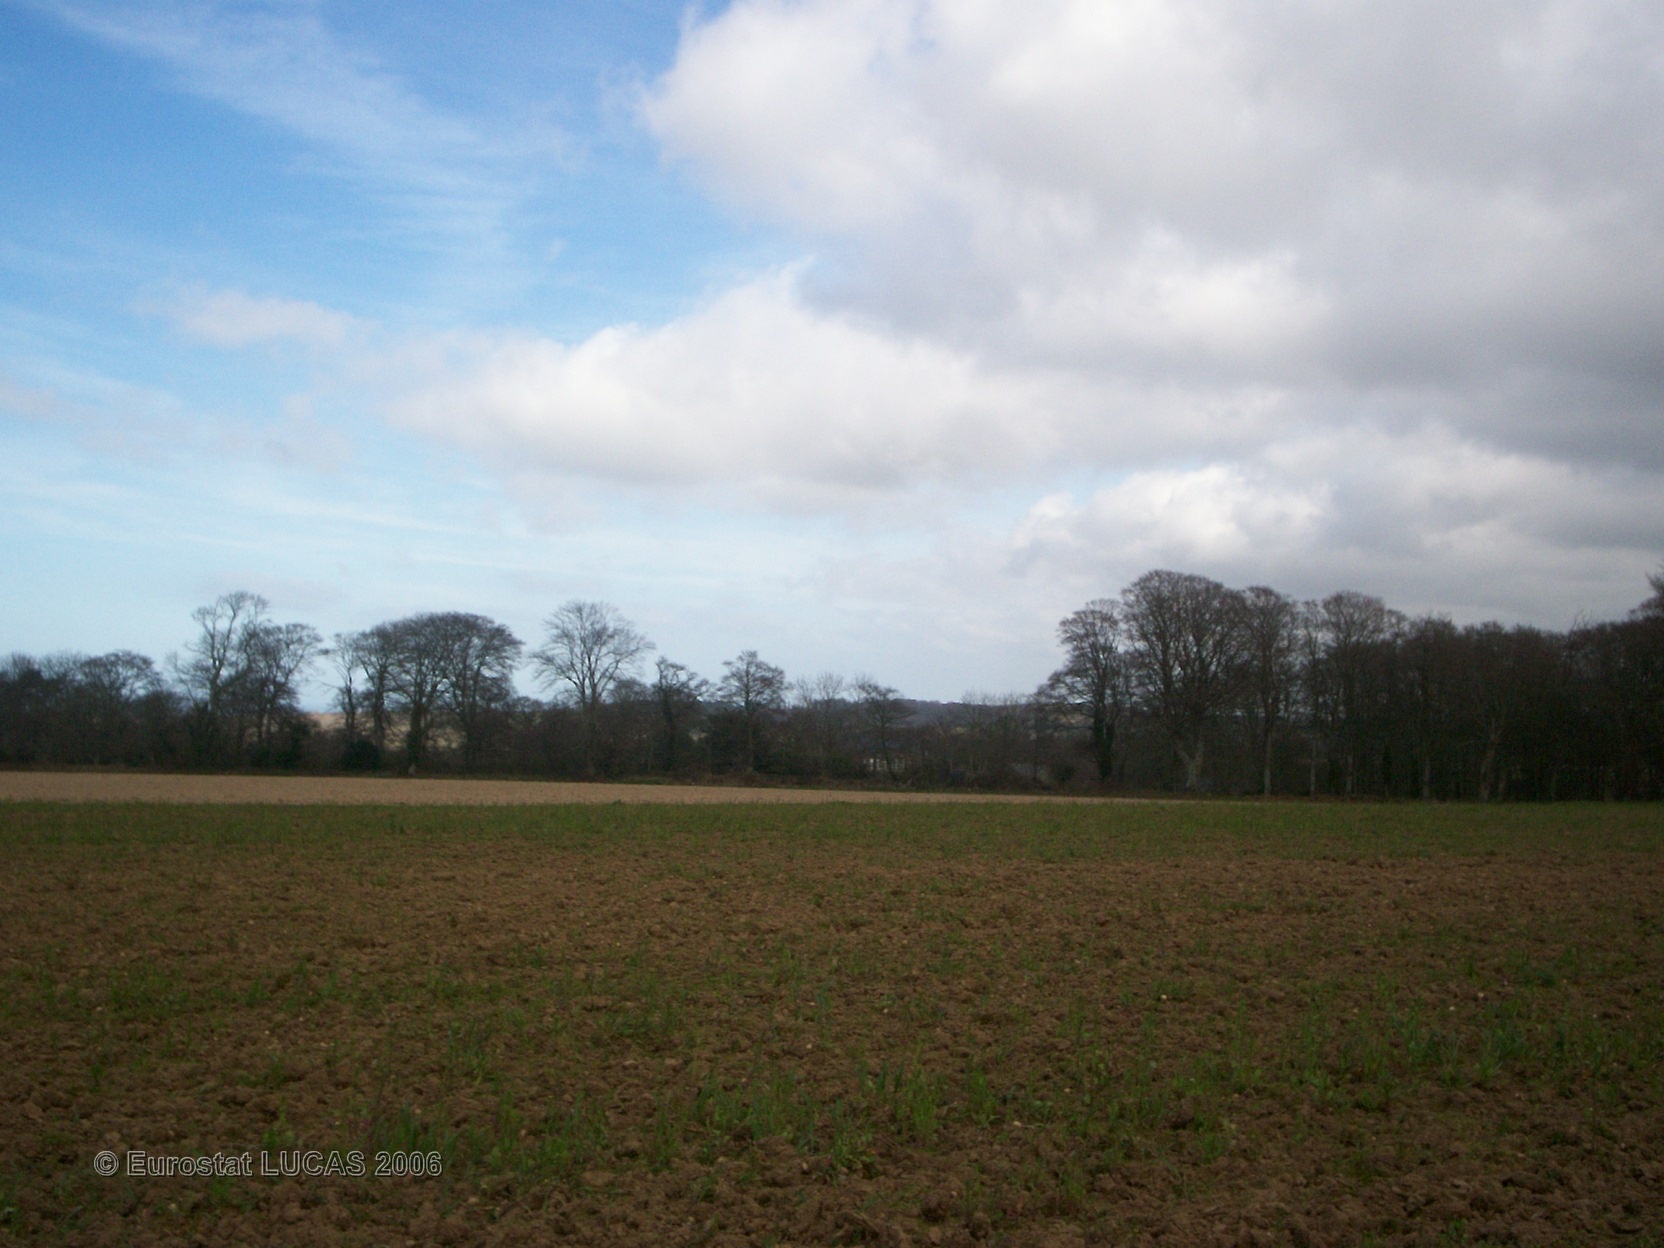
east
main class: Cropland
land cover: Maize
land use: Agriculture (excluding fallow land and kitchen gardens)
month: May
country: FR
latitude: 49.6597
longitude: -1.4502
